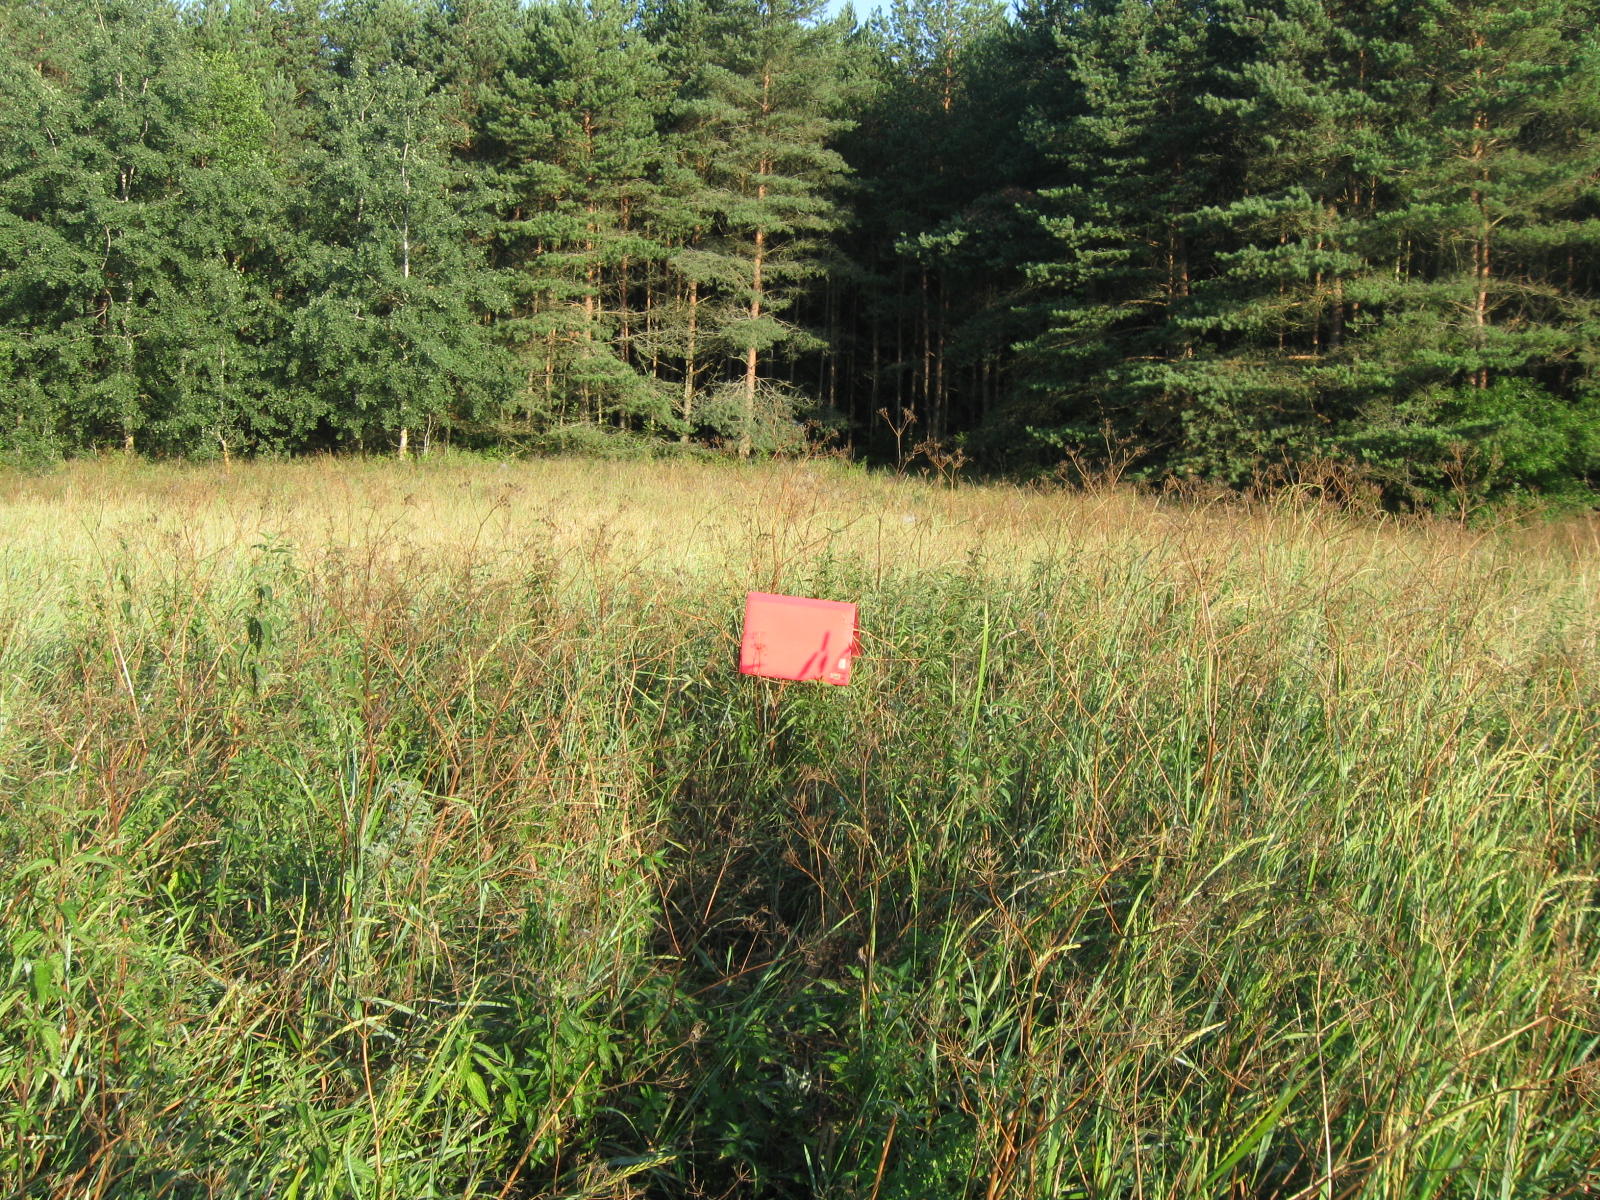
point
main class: Grassland
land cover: Grassland without tree/shrub cover
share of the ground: > 75 %
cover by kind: herbaceous plants 100 %
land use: Agriculture (excluding fallow land and kitchen gardens)
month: July
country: LT
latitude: 54.1382
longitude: 23.8189
